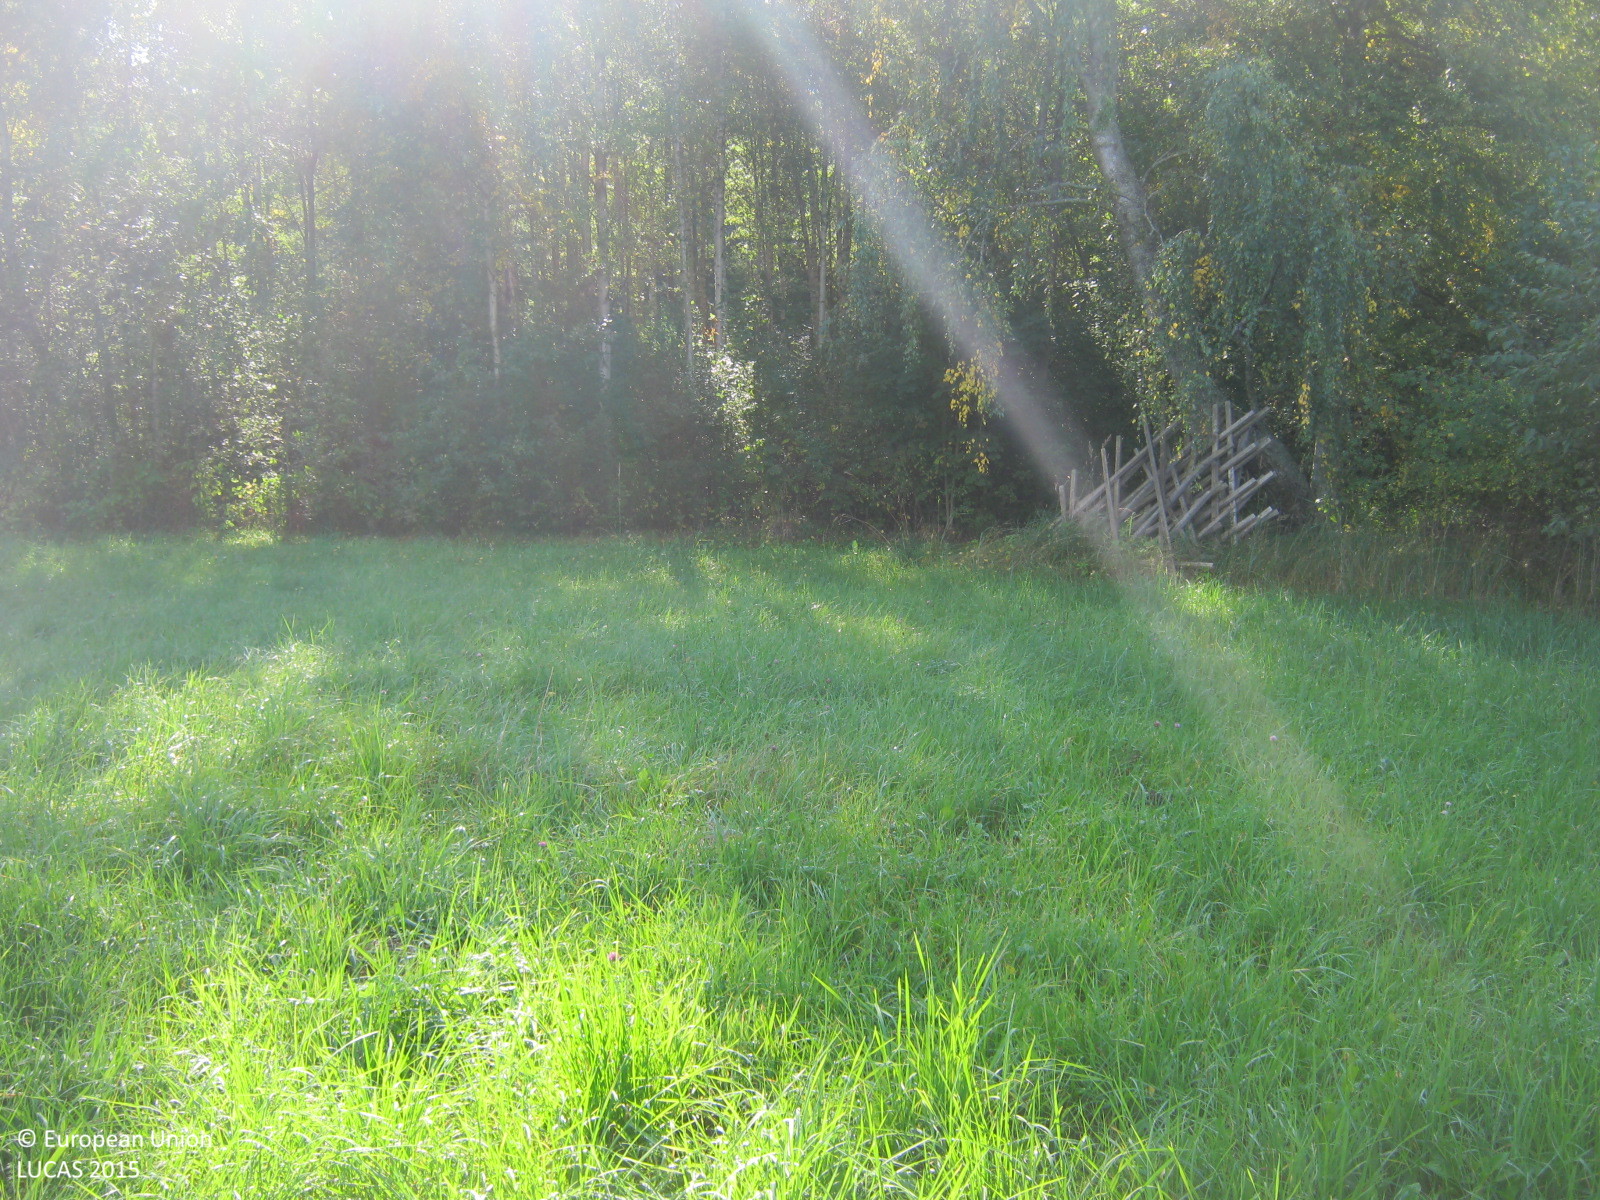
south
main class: Grassland
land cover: Grassland without tree/shrub cover
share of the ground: > 75 %
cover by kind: herbaceous plants 100 %
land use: Agriculture (excluding fallow land and kitchen gardens)
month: September
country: LV
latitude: 57.3644
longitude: 24.4043
